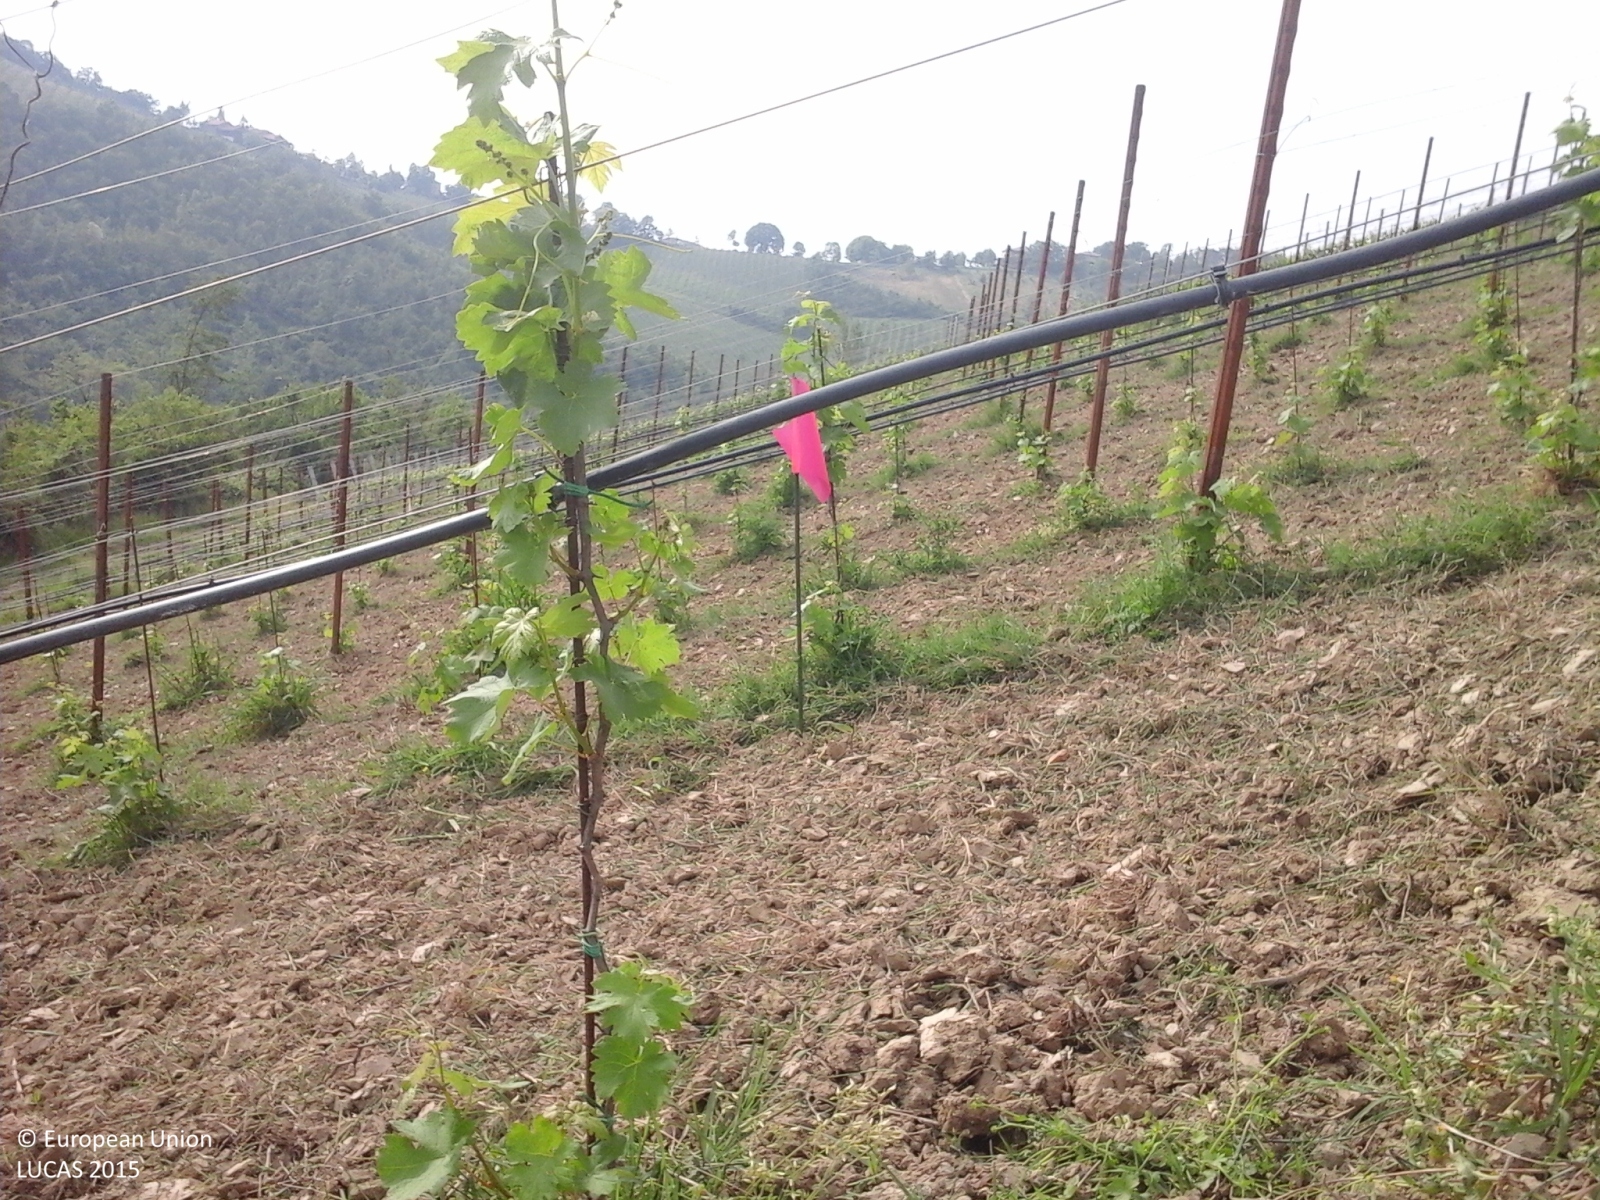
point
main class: Cropland
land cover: Vineyards
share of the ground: < 10 %
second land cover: Other bare soil
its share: > 75 %
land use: Agriculture (excluding fallow land and kitchen gardens)
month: May
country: IT
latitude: 44.4713
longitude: 11.0662
